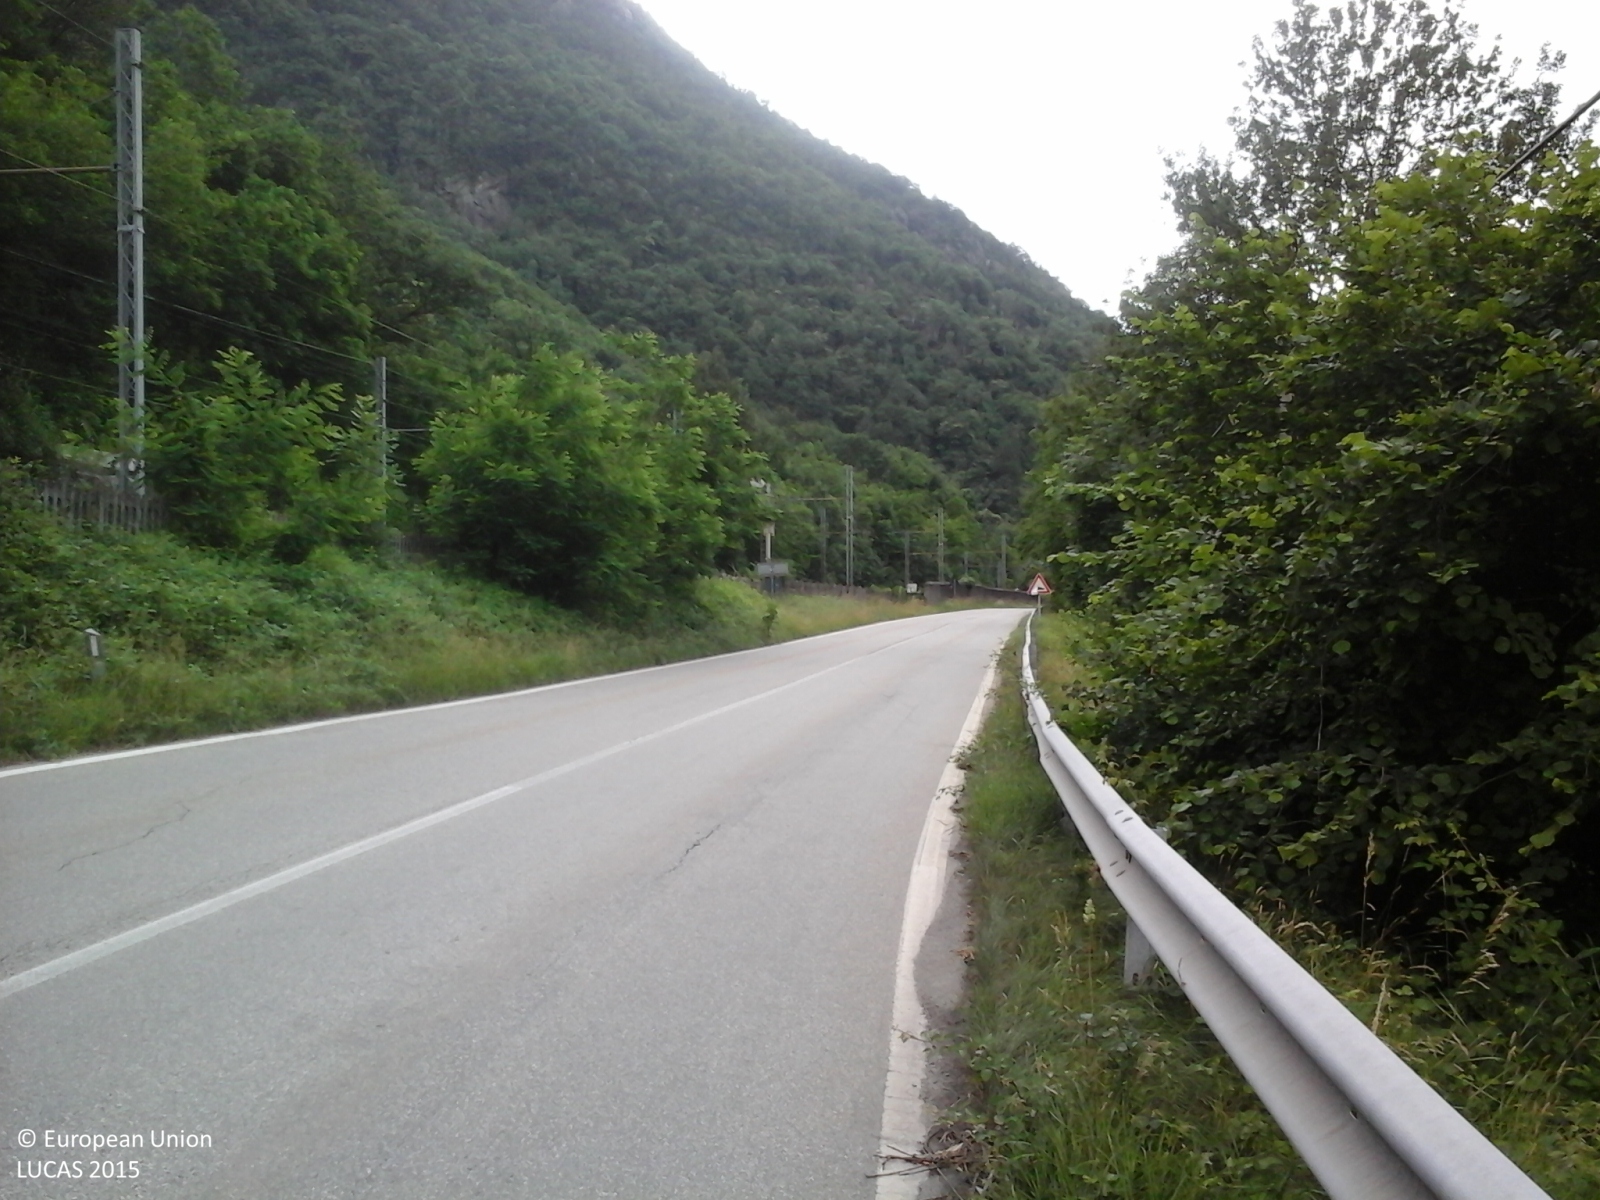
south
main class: Woodland
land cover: Broadleaved woodland
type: floodplain forest
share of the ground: > 75 %
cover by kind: broadleaved forest trees 100 %
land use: Semi-natural and natural areas not in use
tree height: > 5 m
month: June
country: IT
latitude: 46.0311
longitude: 8.2841
